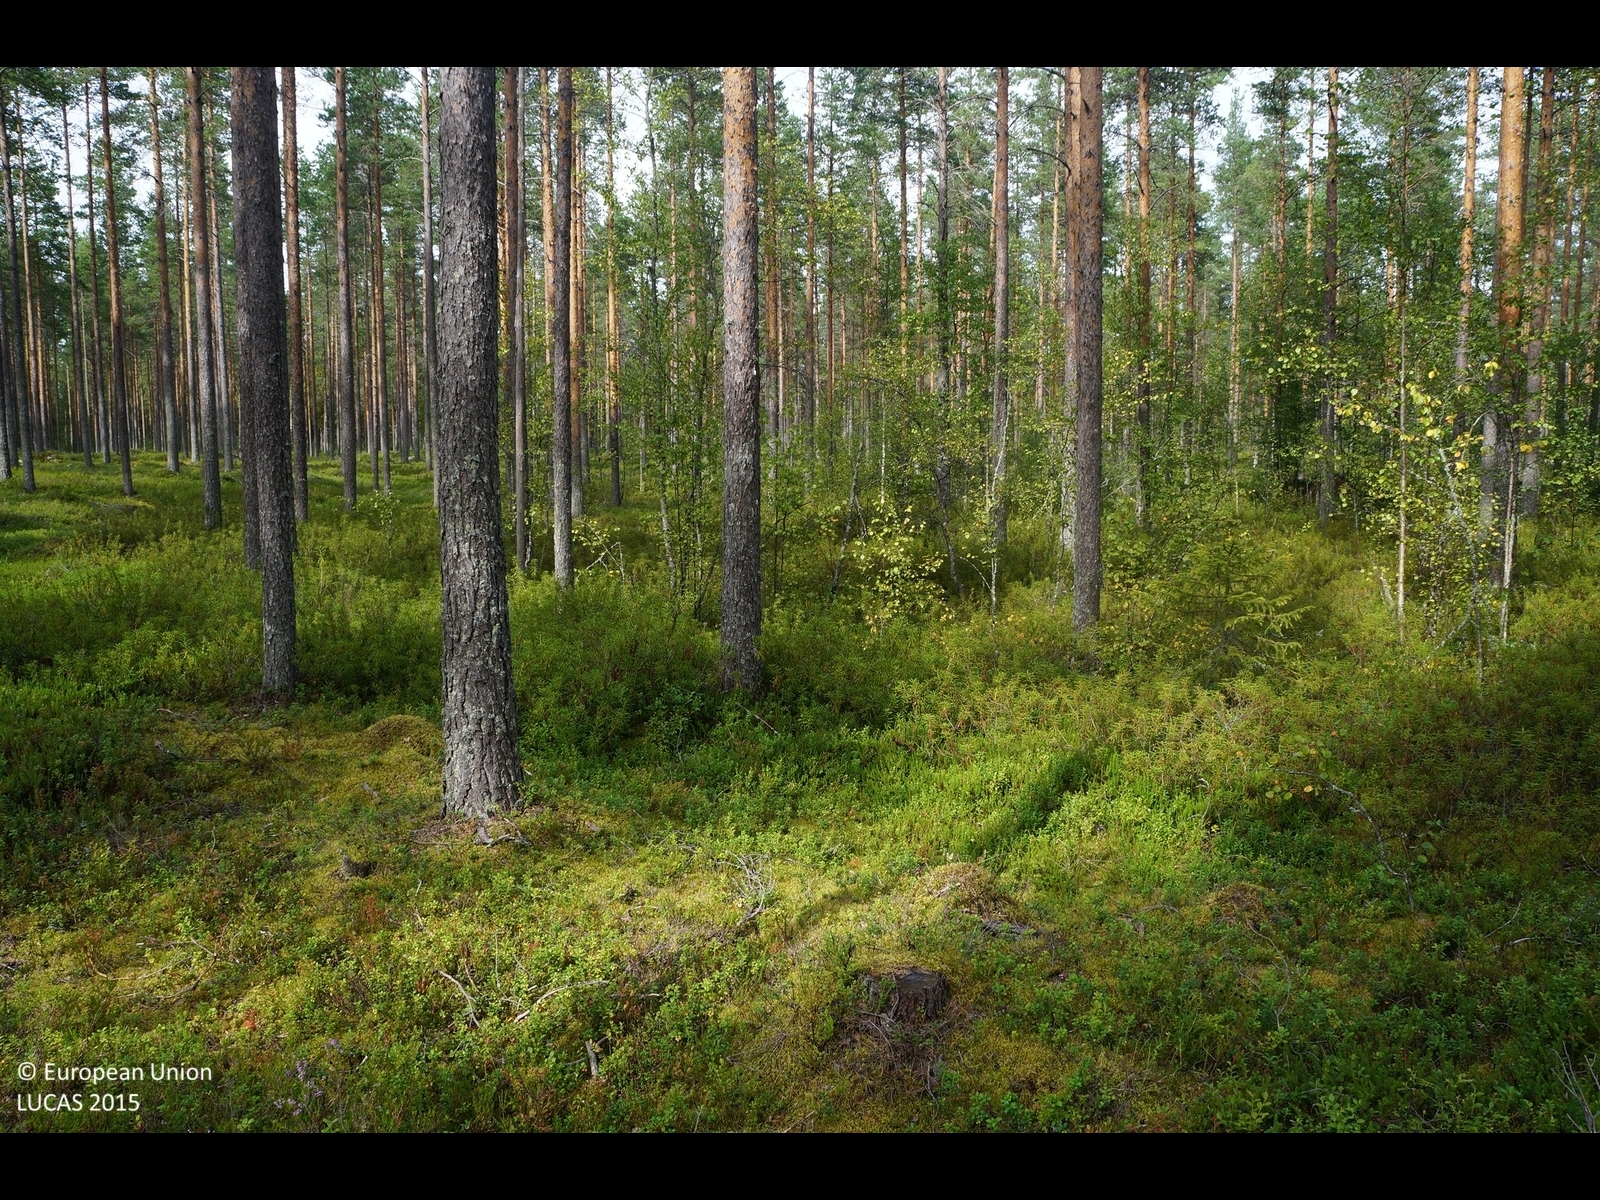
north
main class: Woodland
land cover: Pine dominated coniferous woodland
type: boreal forest
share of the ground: 50 - 75 %
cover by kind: coniferous forest trees 50 %, shrubs 45 %, lichens and mosses 5 %
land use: Forestry
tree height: > 5 m
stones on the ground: < 10 %
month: August
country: FI
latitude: 64.6199
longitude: 24.8155
